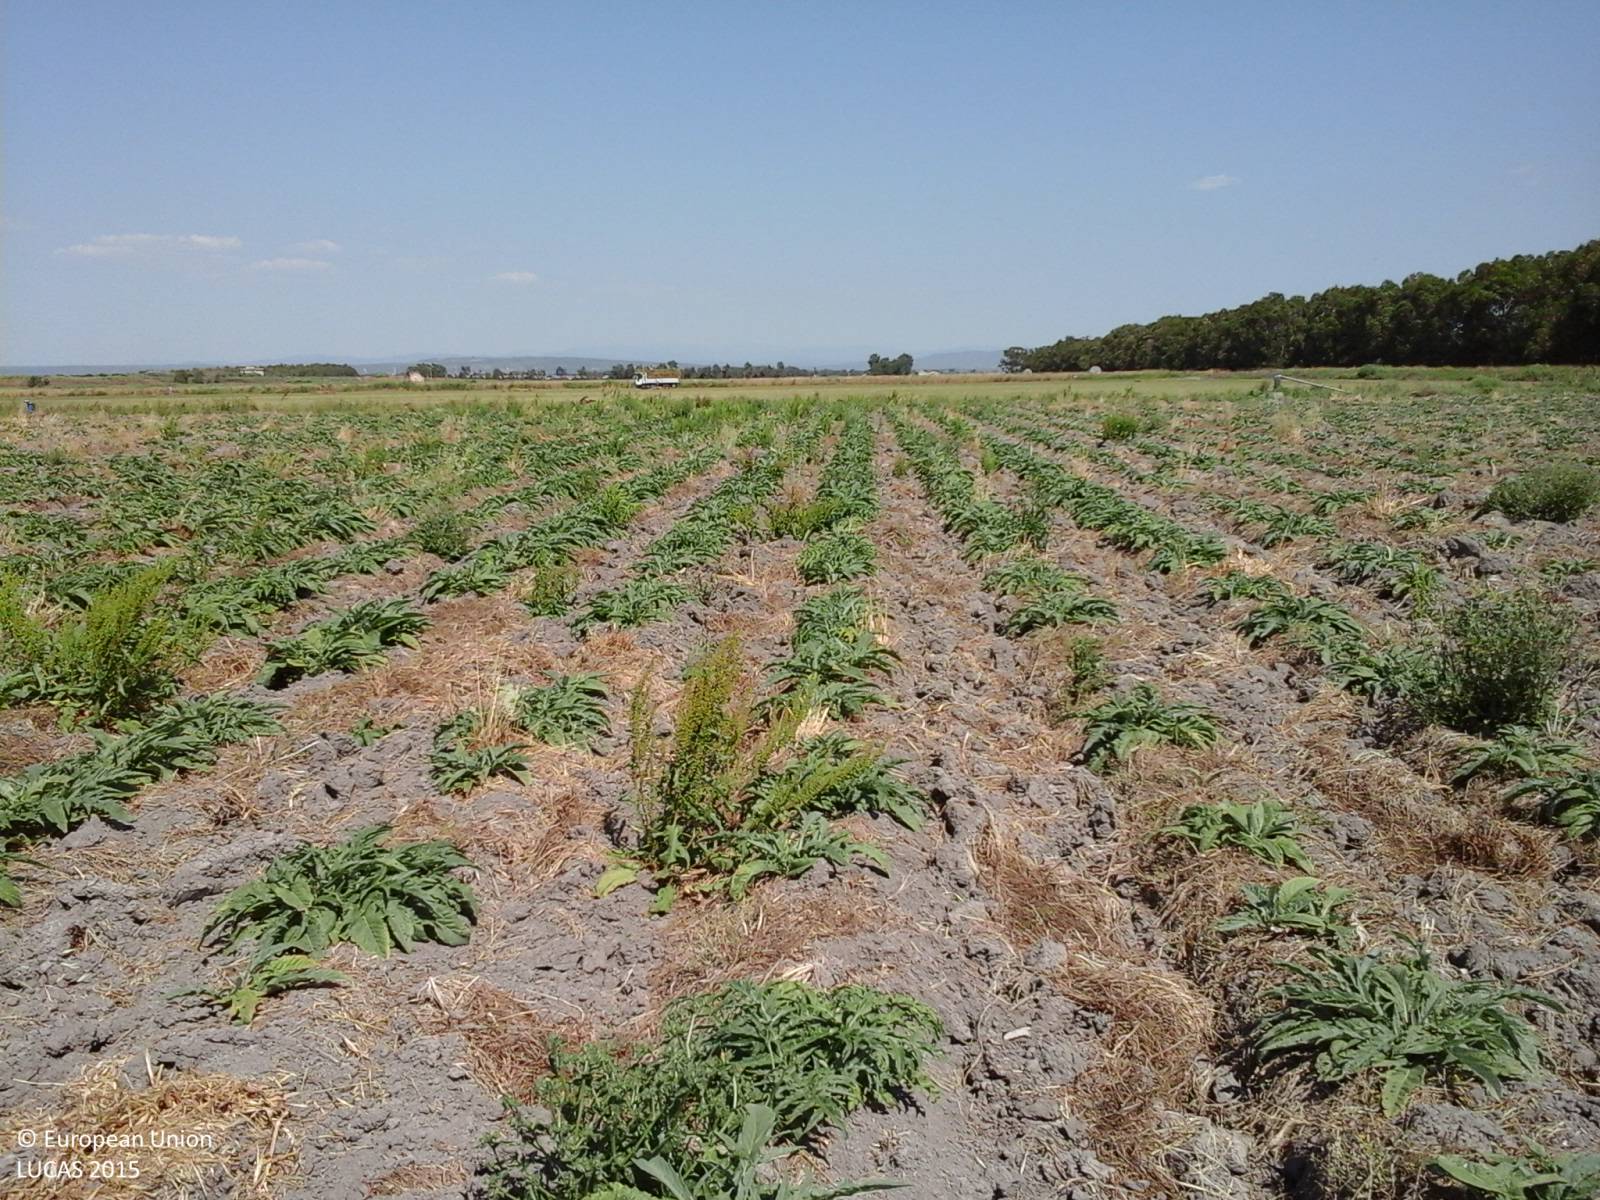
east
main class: Cropland
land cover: Other fresh vegetables
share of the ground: 50 - 75 %
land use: Agriculture (excluding fallow land and kitchen gardens)
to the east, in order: Other fresh vegetables; Grass margins; Ditches and canals; Lucerne
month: July
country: IT
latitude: 40.0030
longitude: 8.5437
